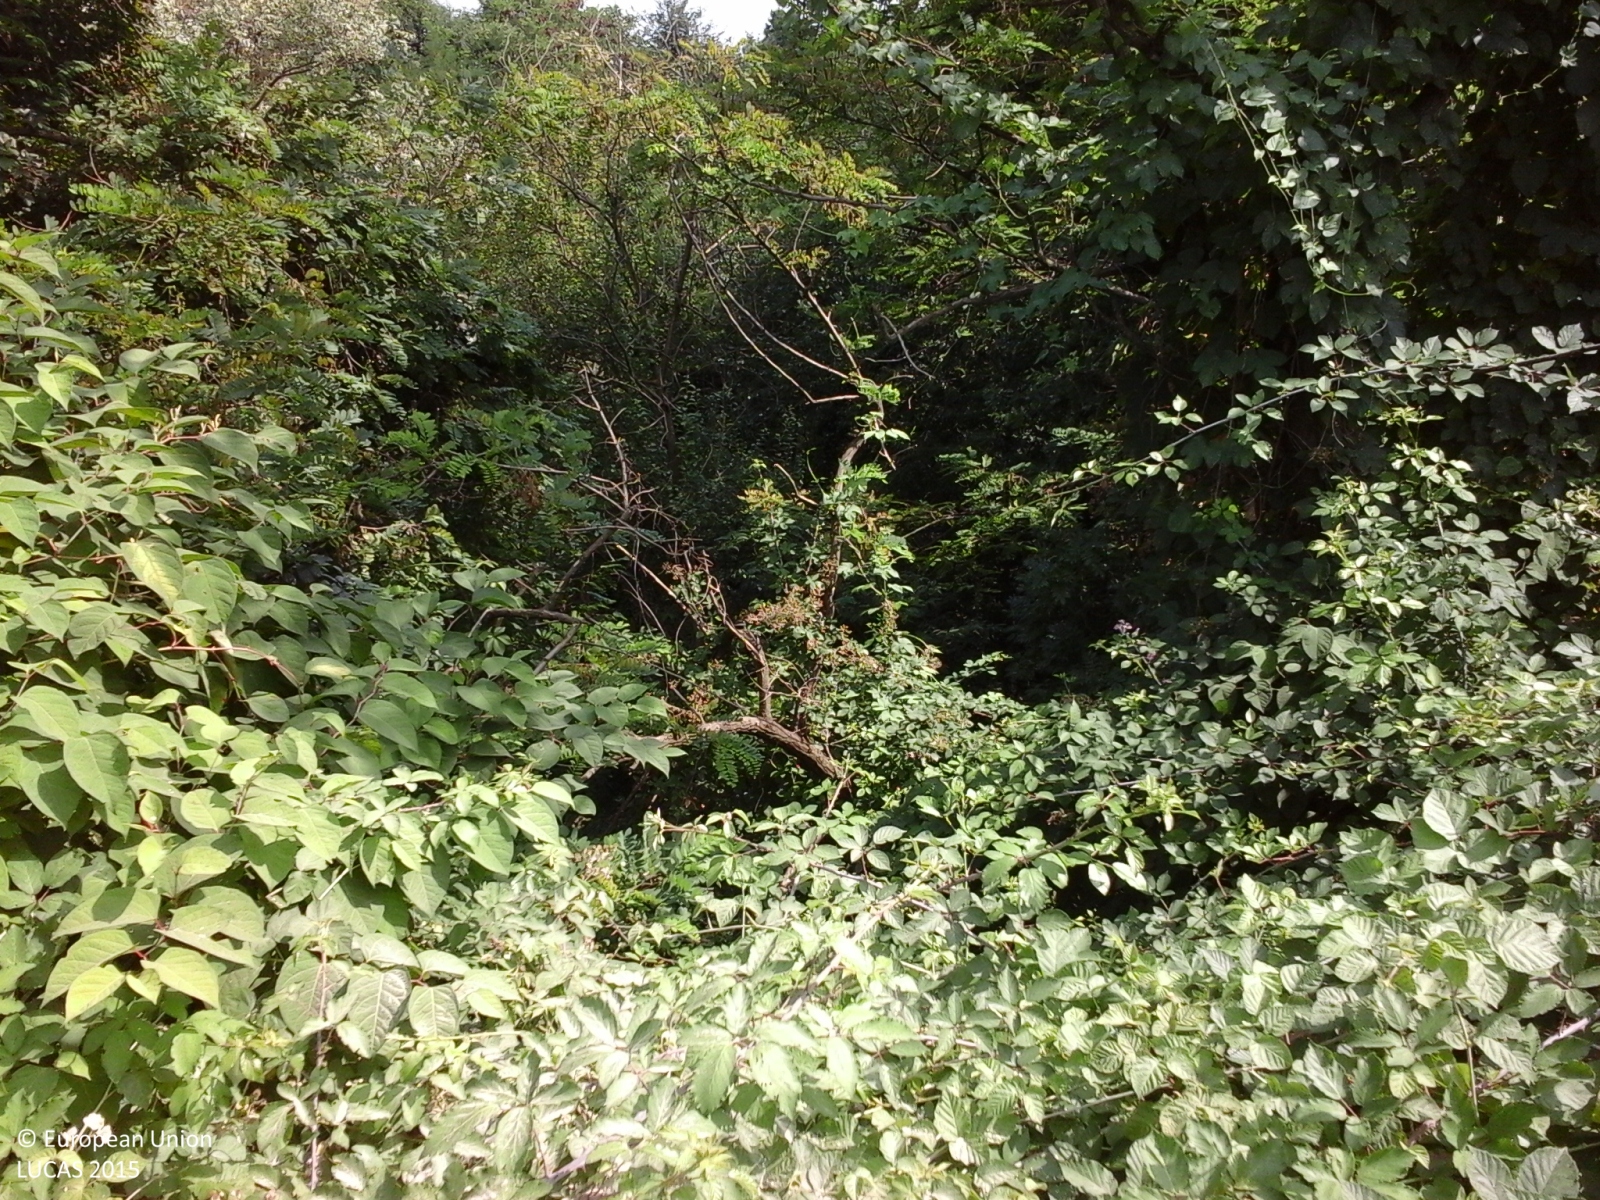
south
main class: Woodland
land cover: Broadleaved woodland
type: thermophilous deciduous forest
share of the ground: > 75 %
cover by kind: broadleaved forest trees 100 %
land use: Semi-natural and natural areas not in use
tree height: > 5 m
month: July
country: IT
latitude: 44.9110
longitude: 7.3069
